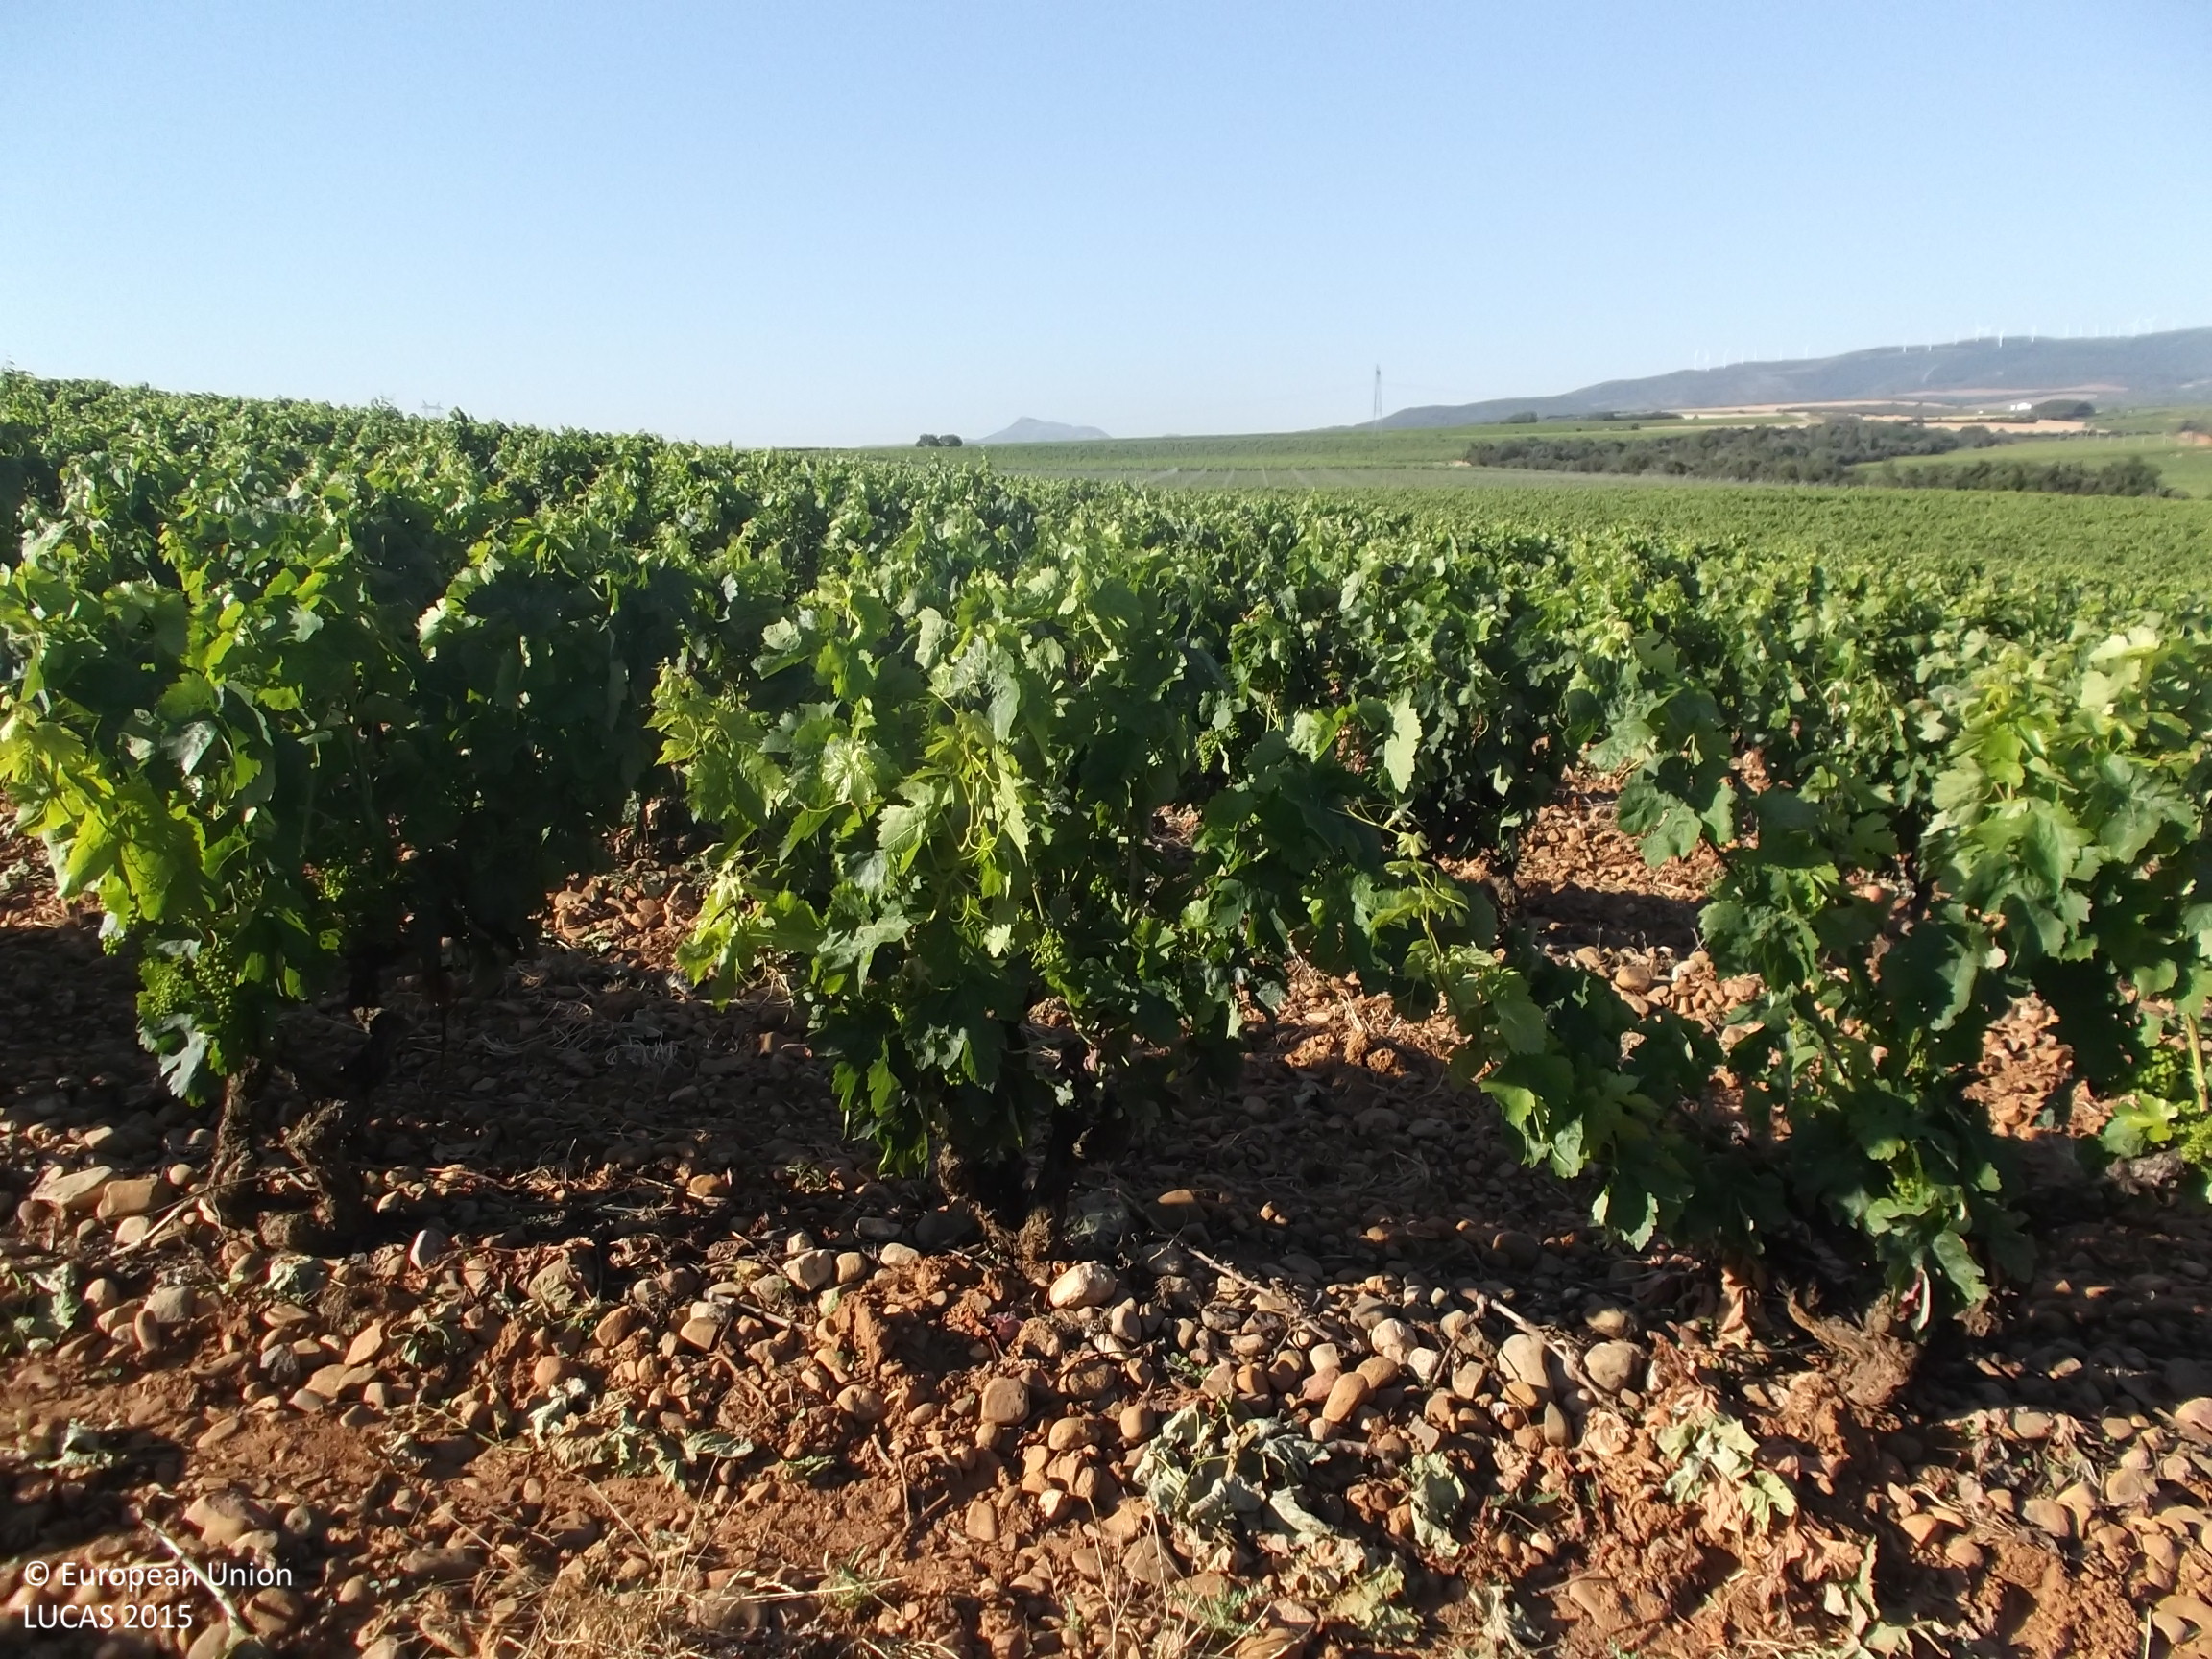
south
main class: Cropland
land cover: Vineyards
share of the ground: 10 - 25 %
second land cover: Other bare soil
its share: > 75 %
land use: Agriculture (excluding fallow land and kitchen gardens)
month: June
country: ES
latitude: 42.3225
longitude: -2.1377
